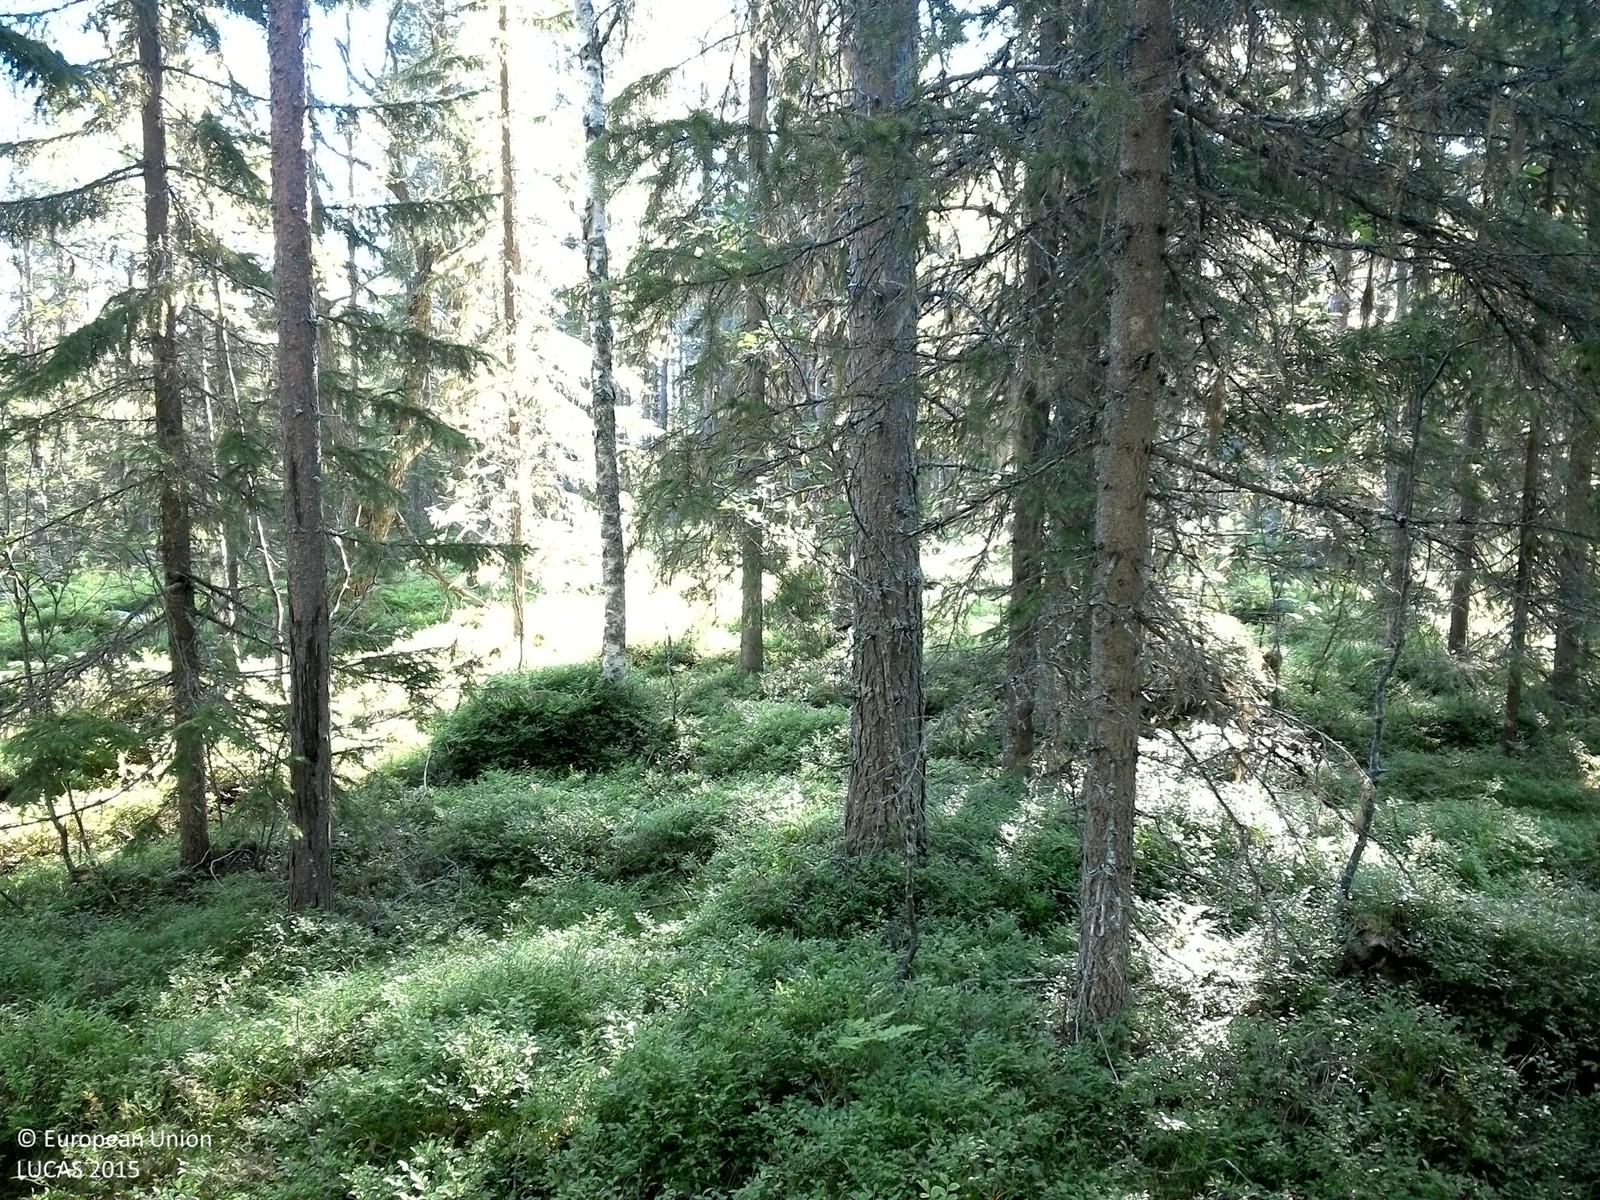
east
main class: Woodland
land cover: Other coniferous woodland
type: boreal forest
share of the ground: 50 - 75 %
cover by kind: coniferous forest trees 55 %, shrubs 20 %, broadleaved forest trees 10 %, lichens and mosses 10 %, consolidated bare surface 5 %
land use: Forestry
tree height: > 5 m
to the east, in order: Other coniferous woodland; Pine dominated coniferous woodland; Other coniferous woodland; Pine dominated coniferous woodland
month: August
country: SE
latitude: 64.0371
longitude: 16.7470
